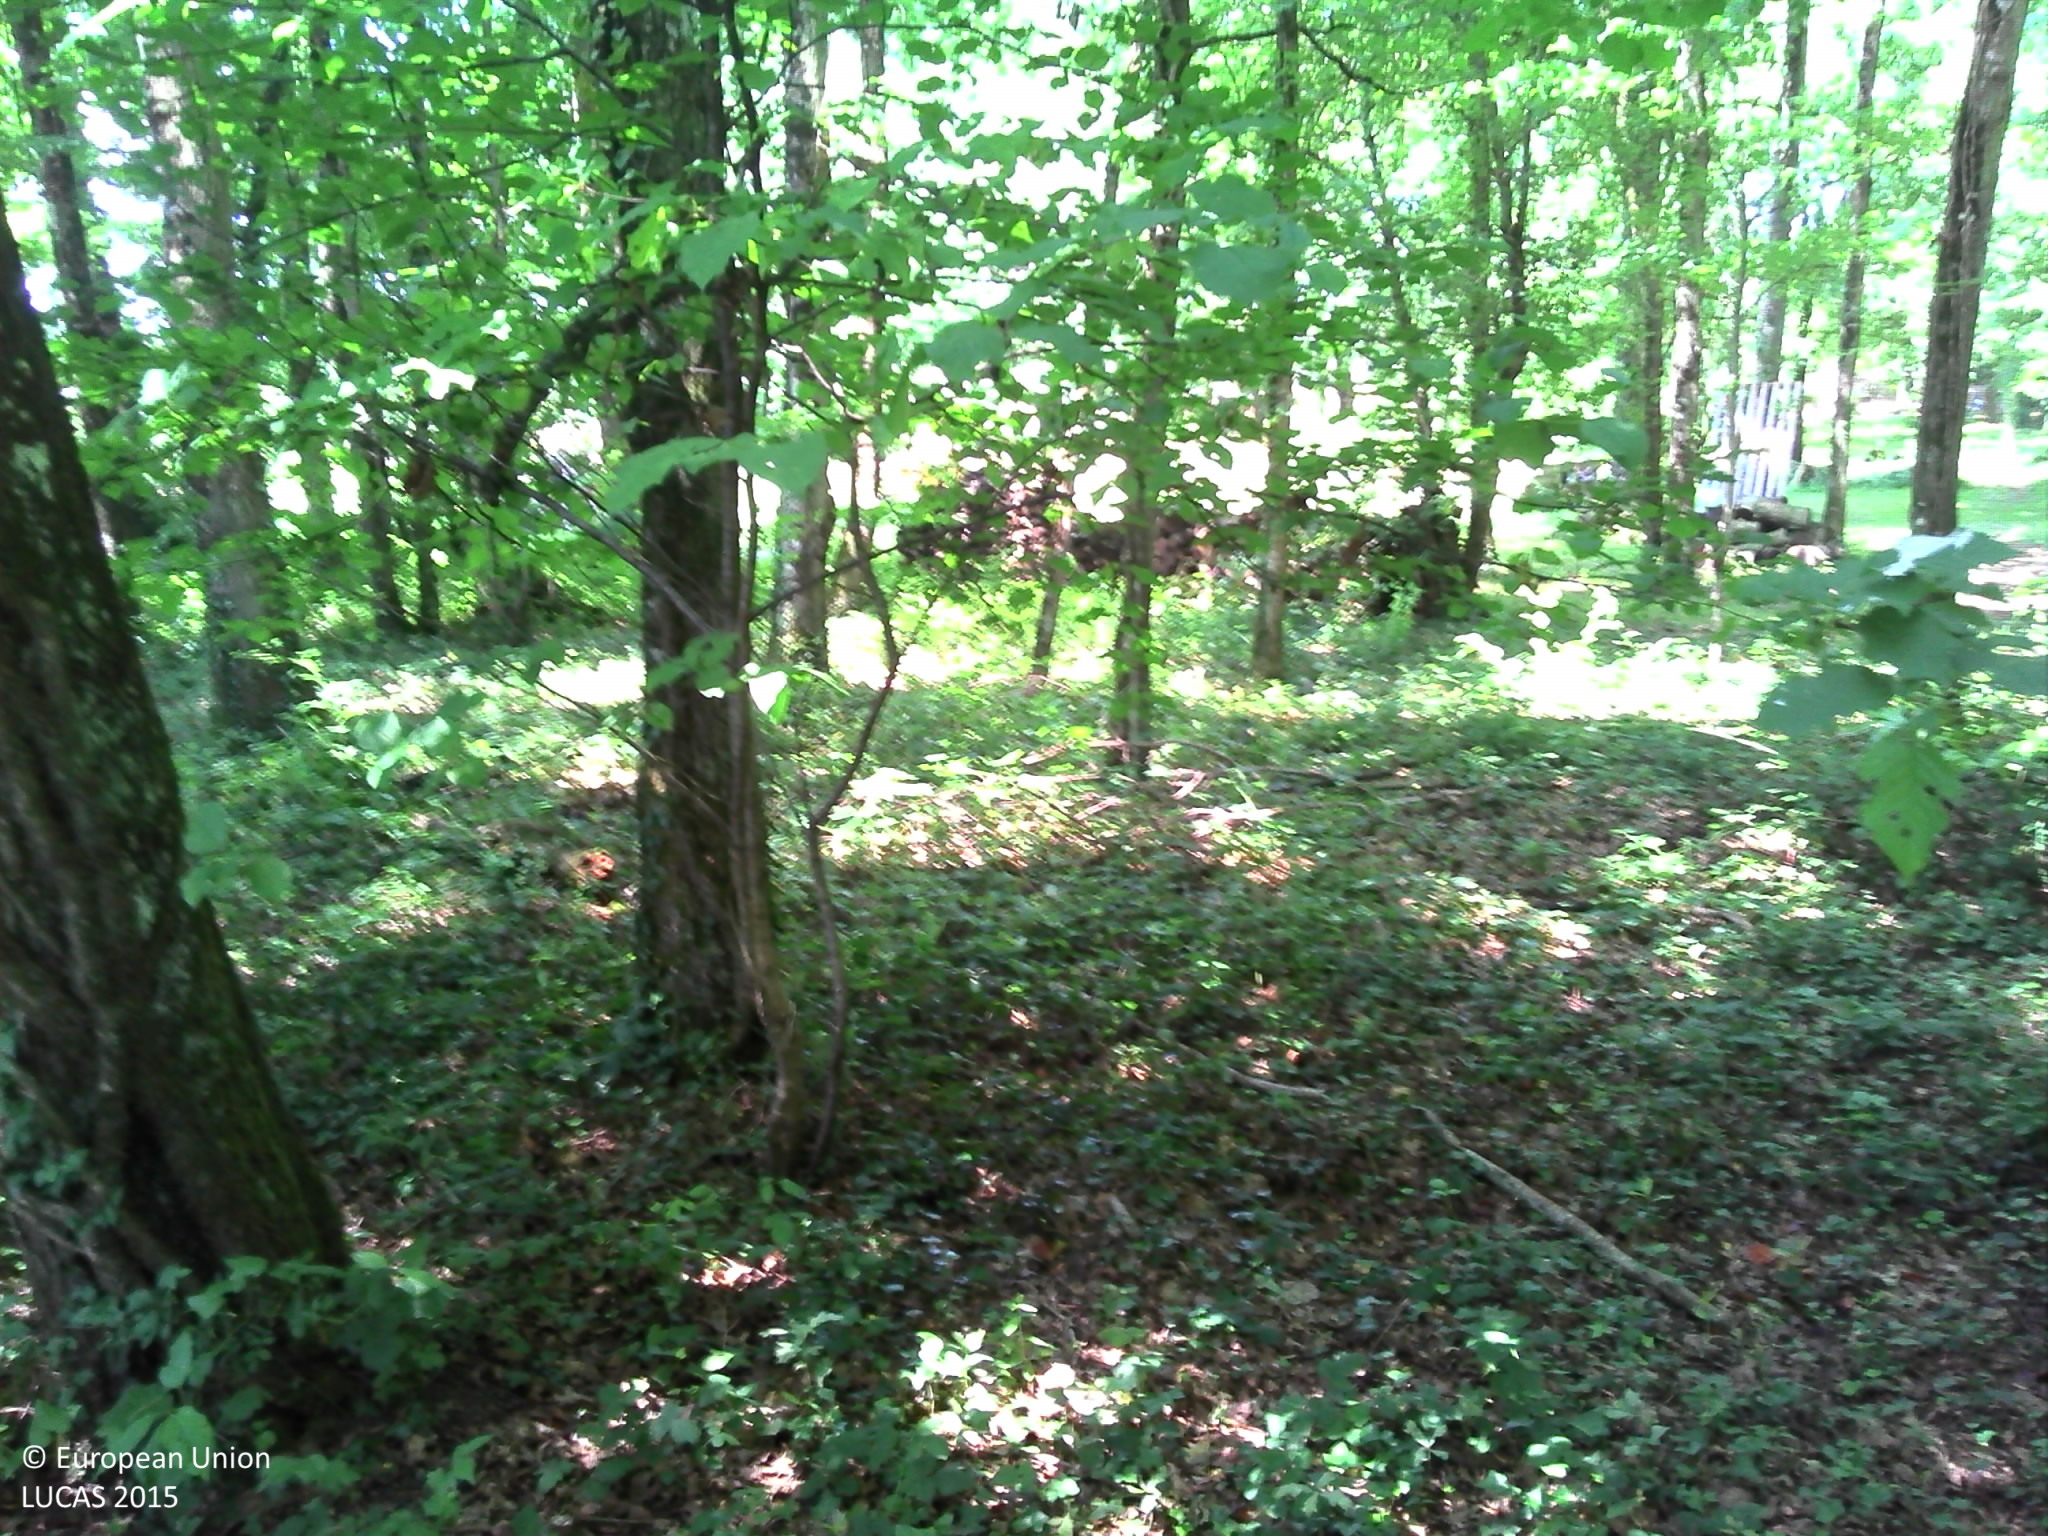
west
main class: Woodland
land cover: Broadleaved woodland
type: mesophytic deciduous forest
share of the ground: > 75 %
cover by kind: broadleaved forest trees 95 %, herbaceous plants 5 %
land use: Forestry
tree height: > 5 m
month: June
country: FR
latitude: 46.5395
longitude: 0.4500
